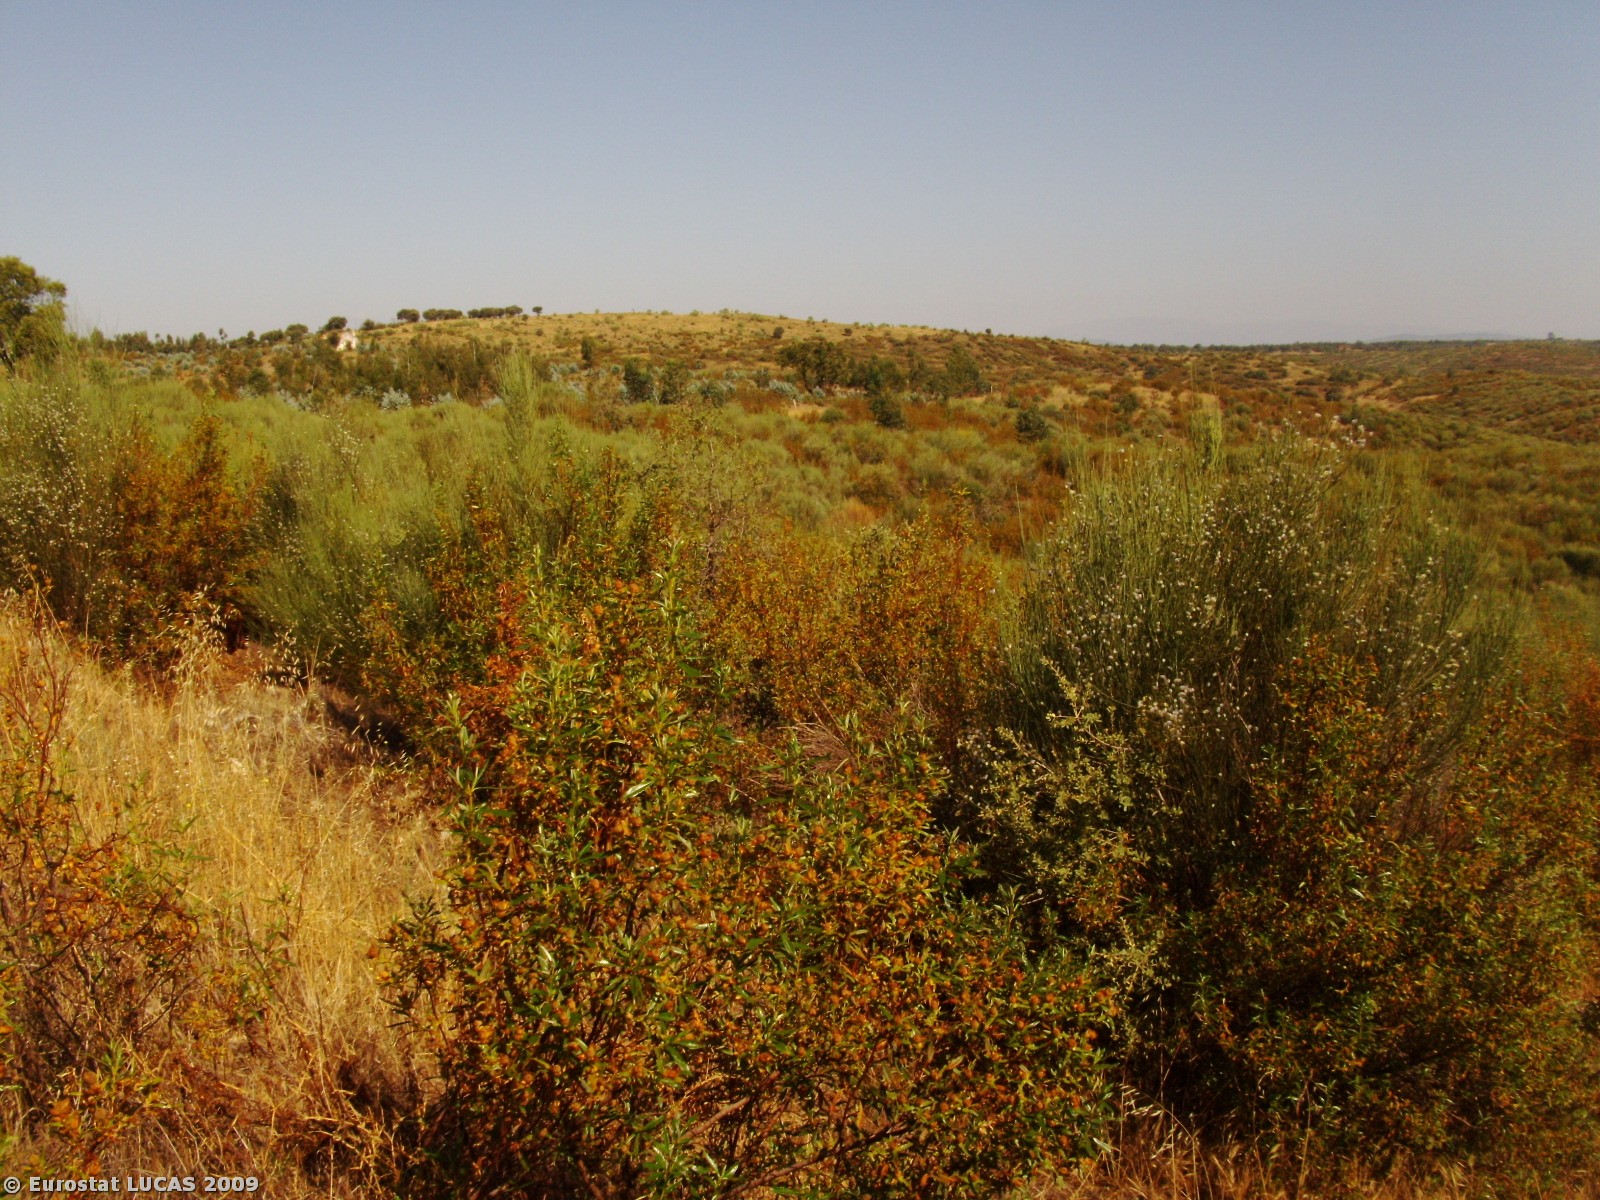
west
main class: Shrubland
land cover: Shrubland with sparse tree cover
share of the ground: > 75 %
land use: Unused
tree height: > 5 m
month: June
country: PT
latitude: 39.9848
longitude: -7.2282
